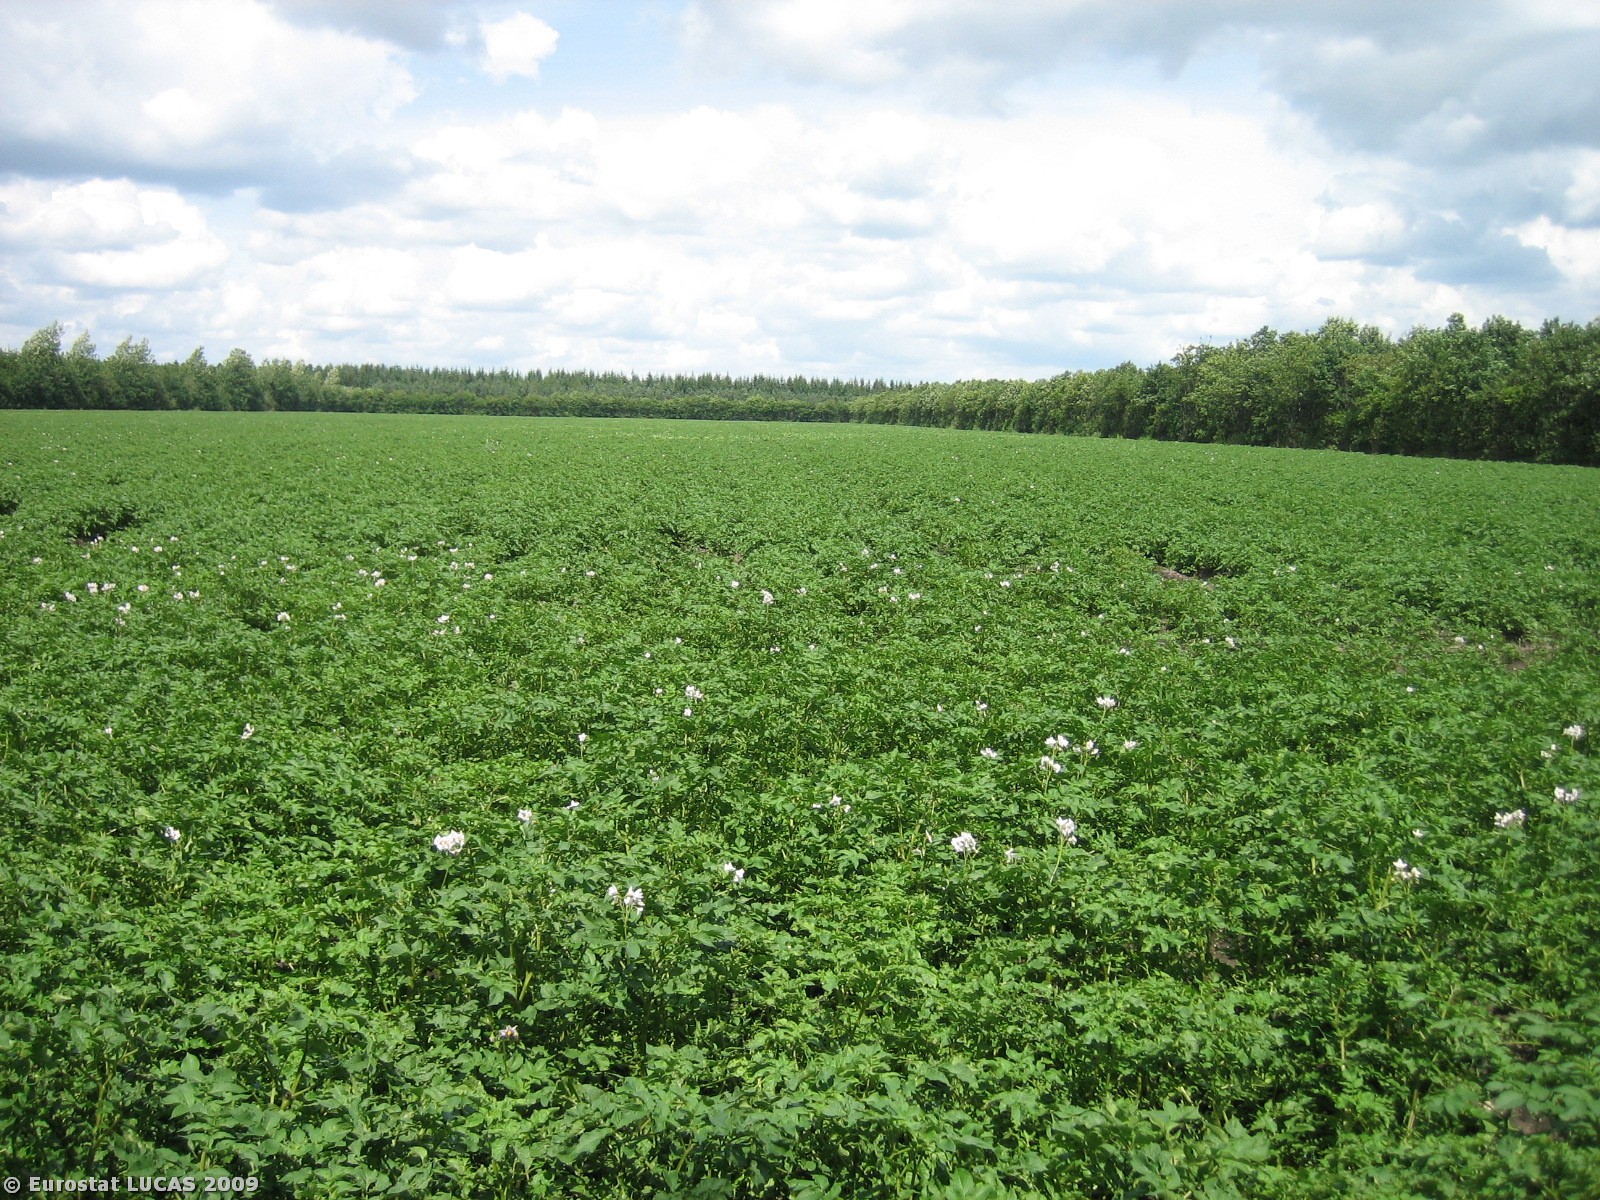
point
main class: Cropland
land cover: Potatoes
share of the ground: > 75 %
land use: Agriculture (excluding fallow land and kitchen gardens)
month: July
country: DK
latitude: 55.7698
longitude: 8.9331
